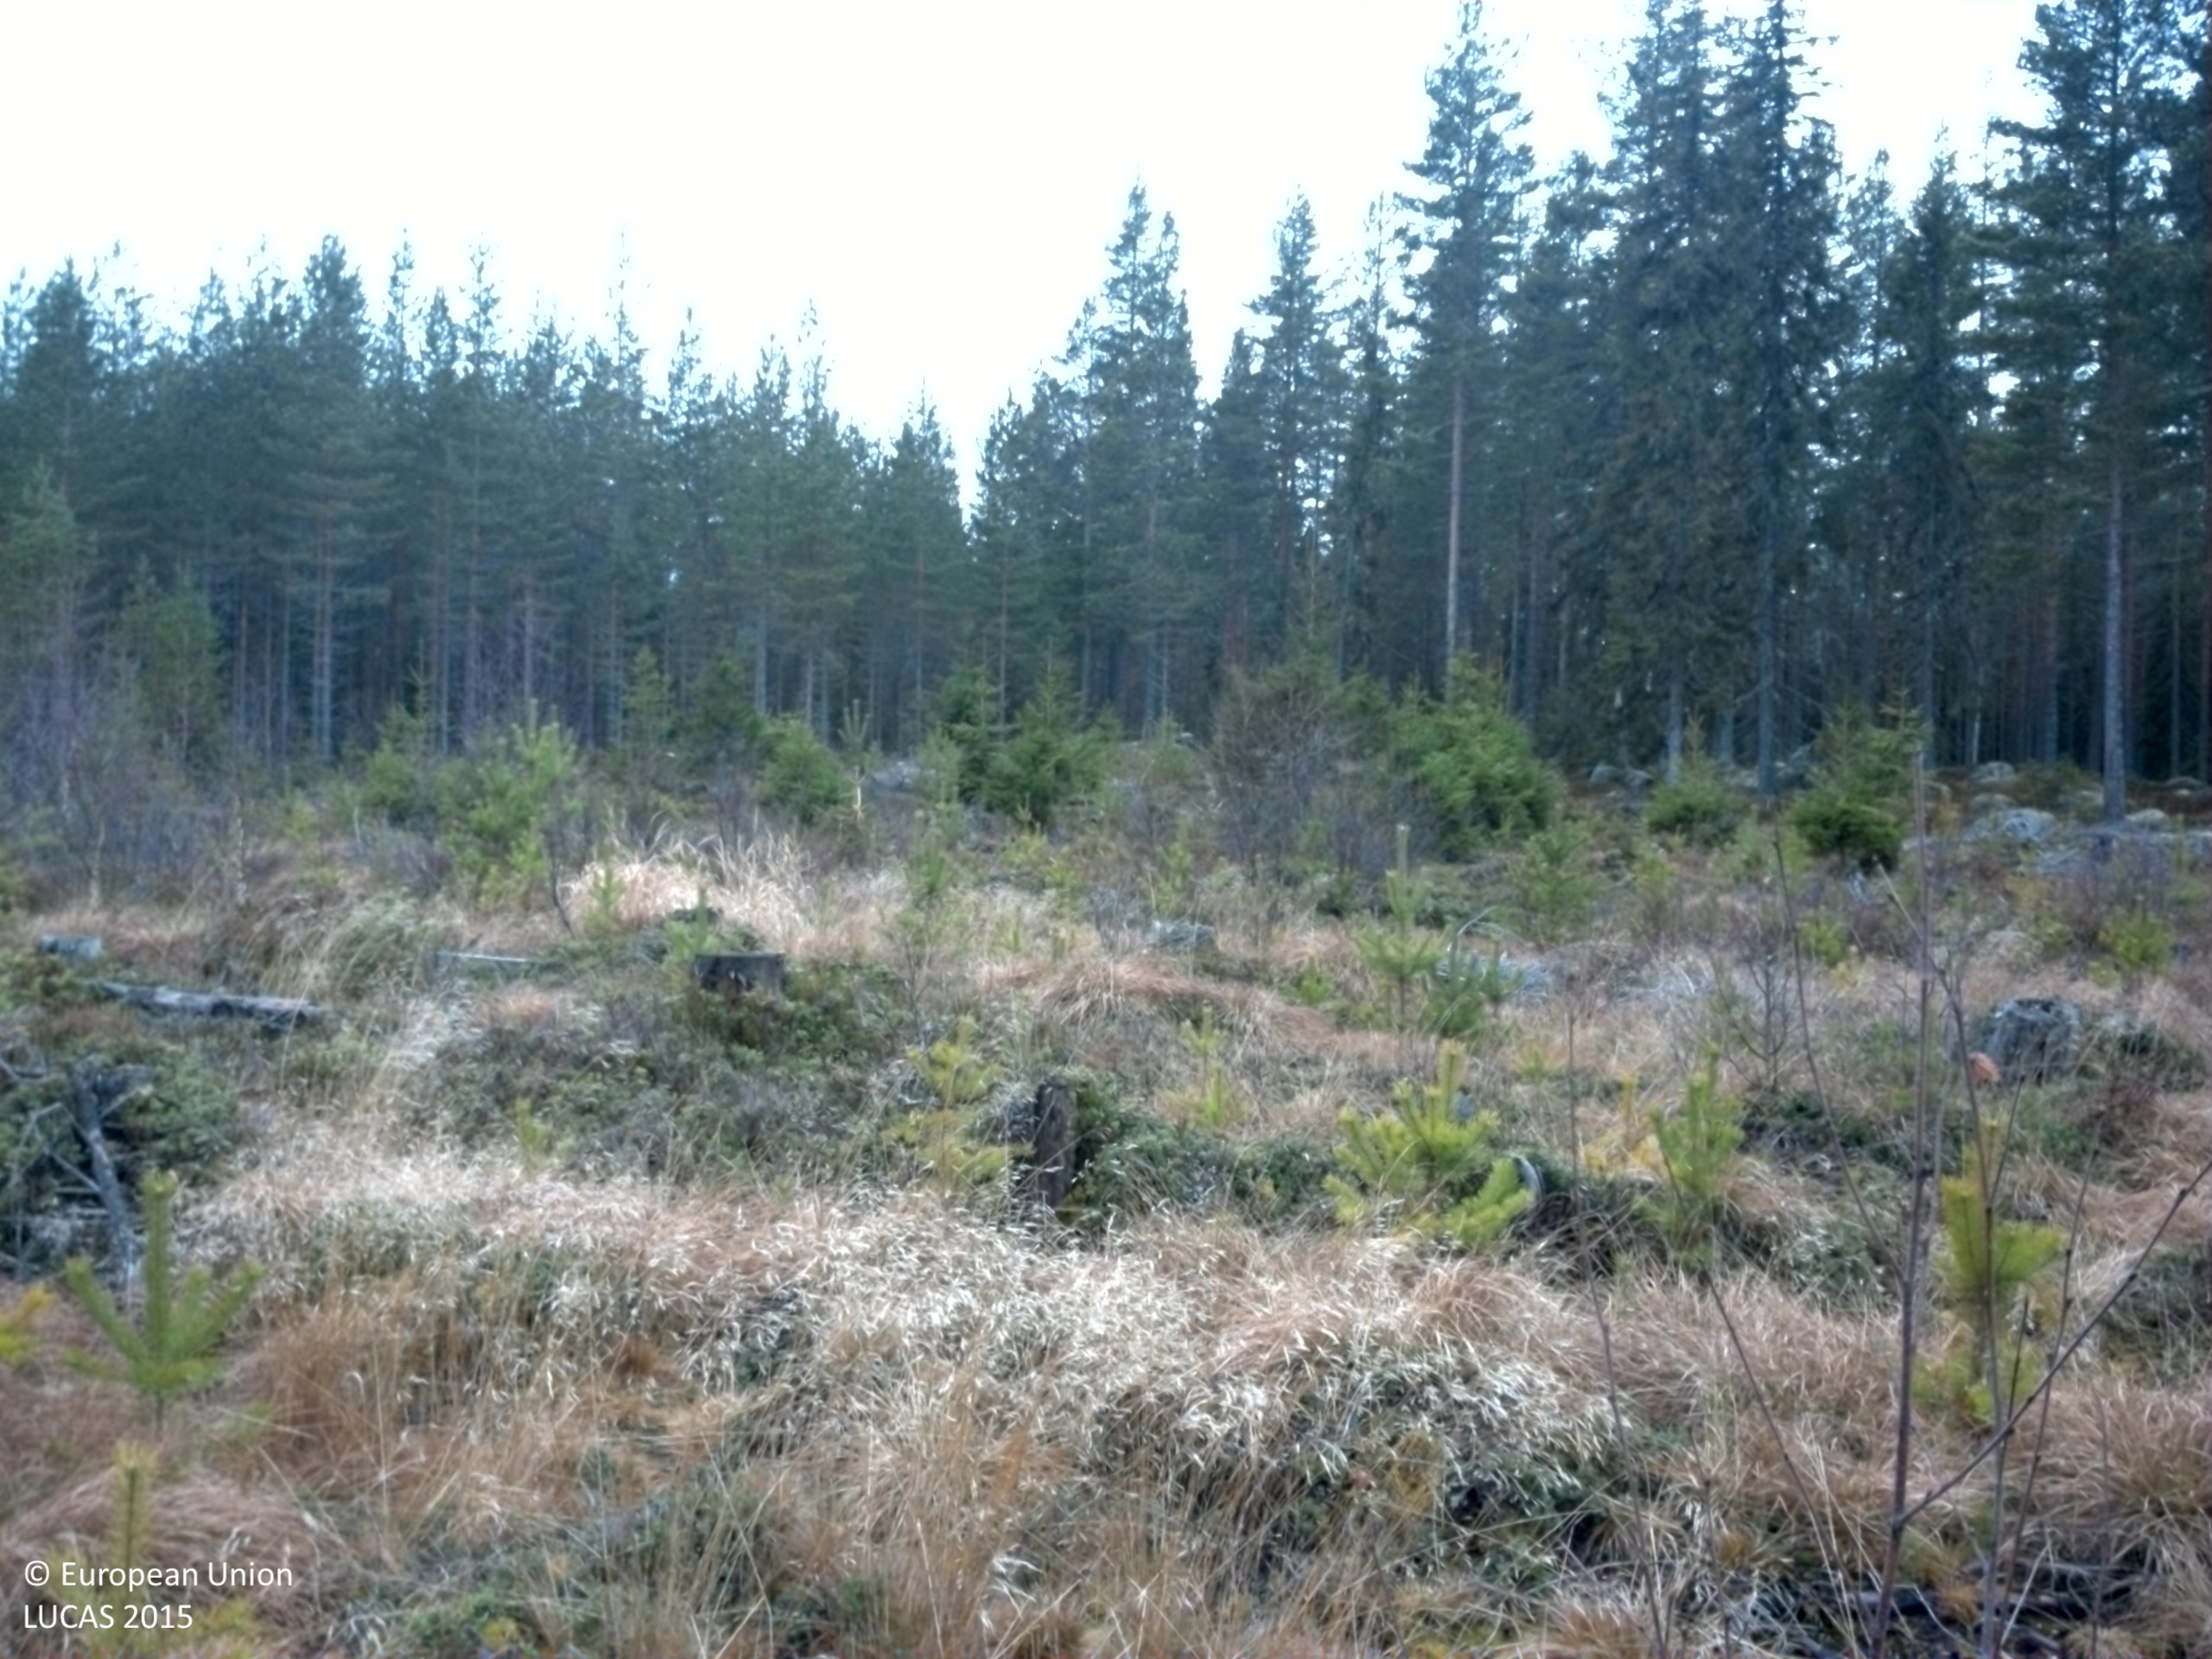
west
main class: Woodland
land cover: Pine dominated mixed woodland
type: boreal forest
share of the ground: 25 - 50 %
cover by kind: herbaceous plants 30 %, shrubs 25 %, coniferous forest trees 15 %, broadleaved forest trees 10 %, lichens and mosses 10 %, consolidated bare surface 5 %, unconsolidated bare surface 5 %
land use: Forestry
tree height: < 5 m
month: November
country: SE
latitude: 61.5854
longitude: 16.8979
